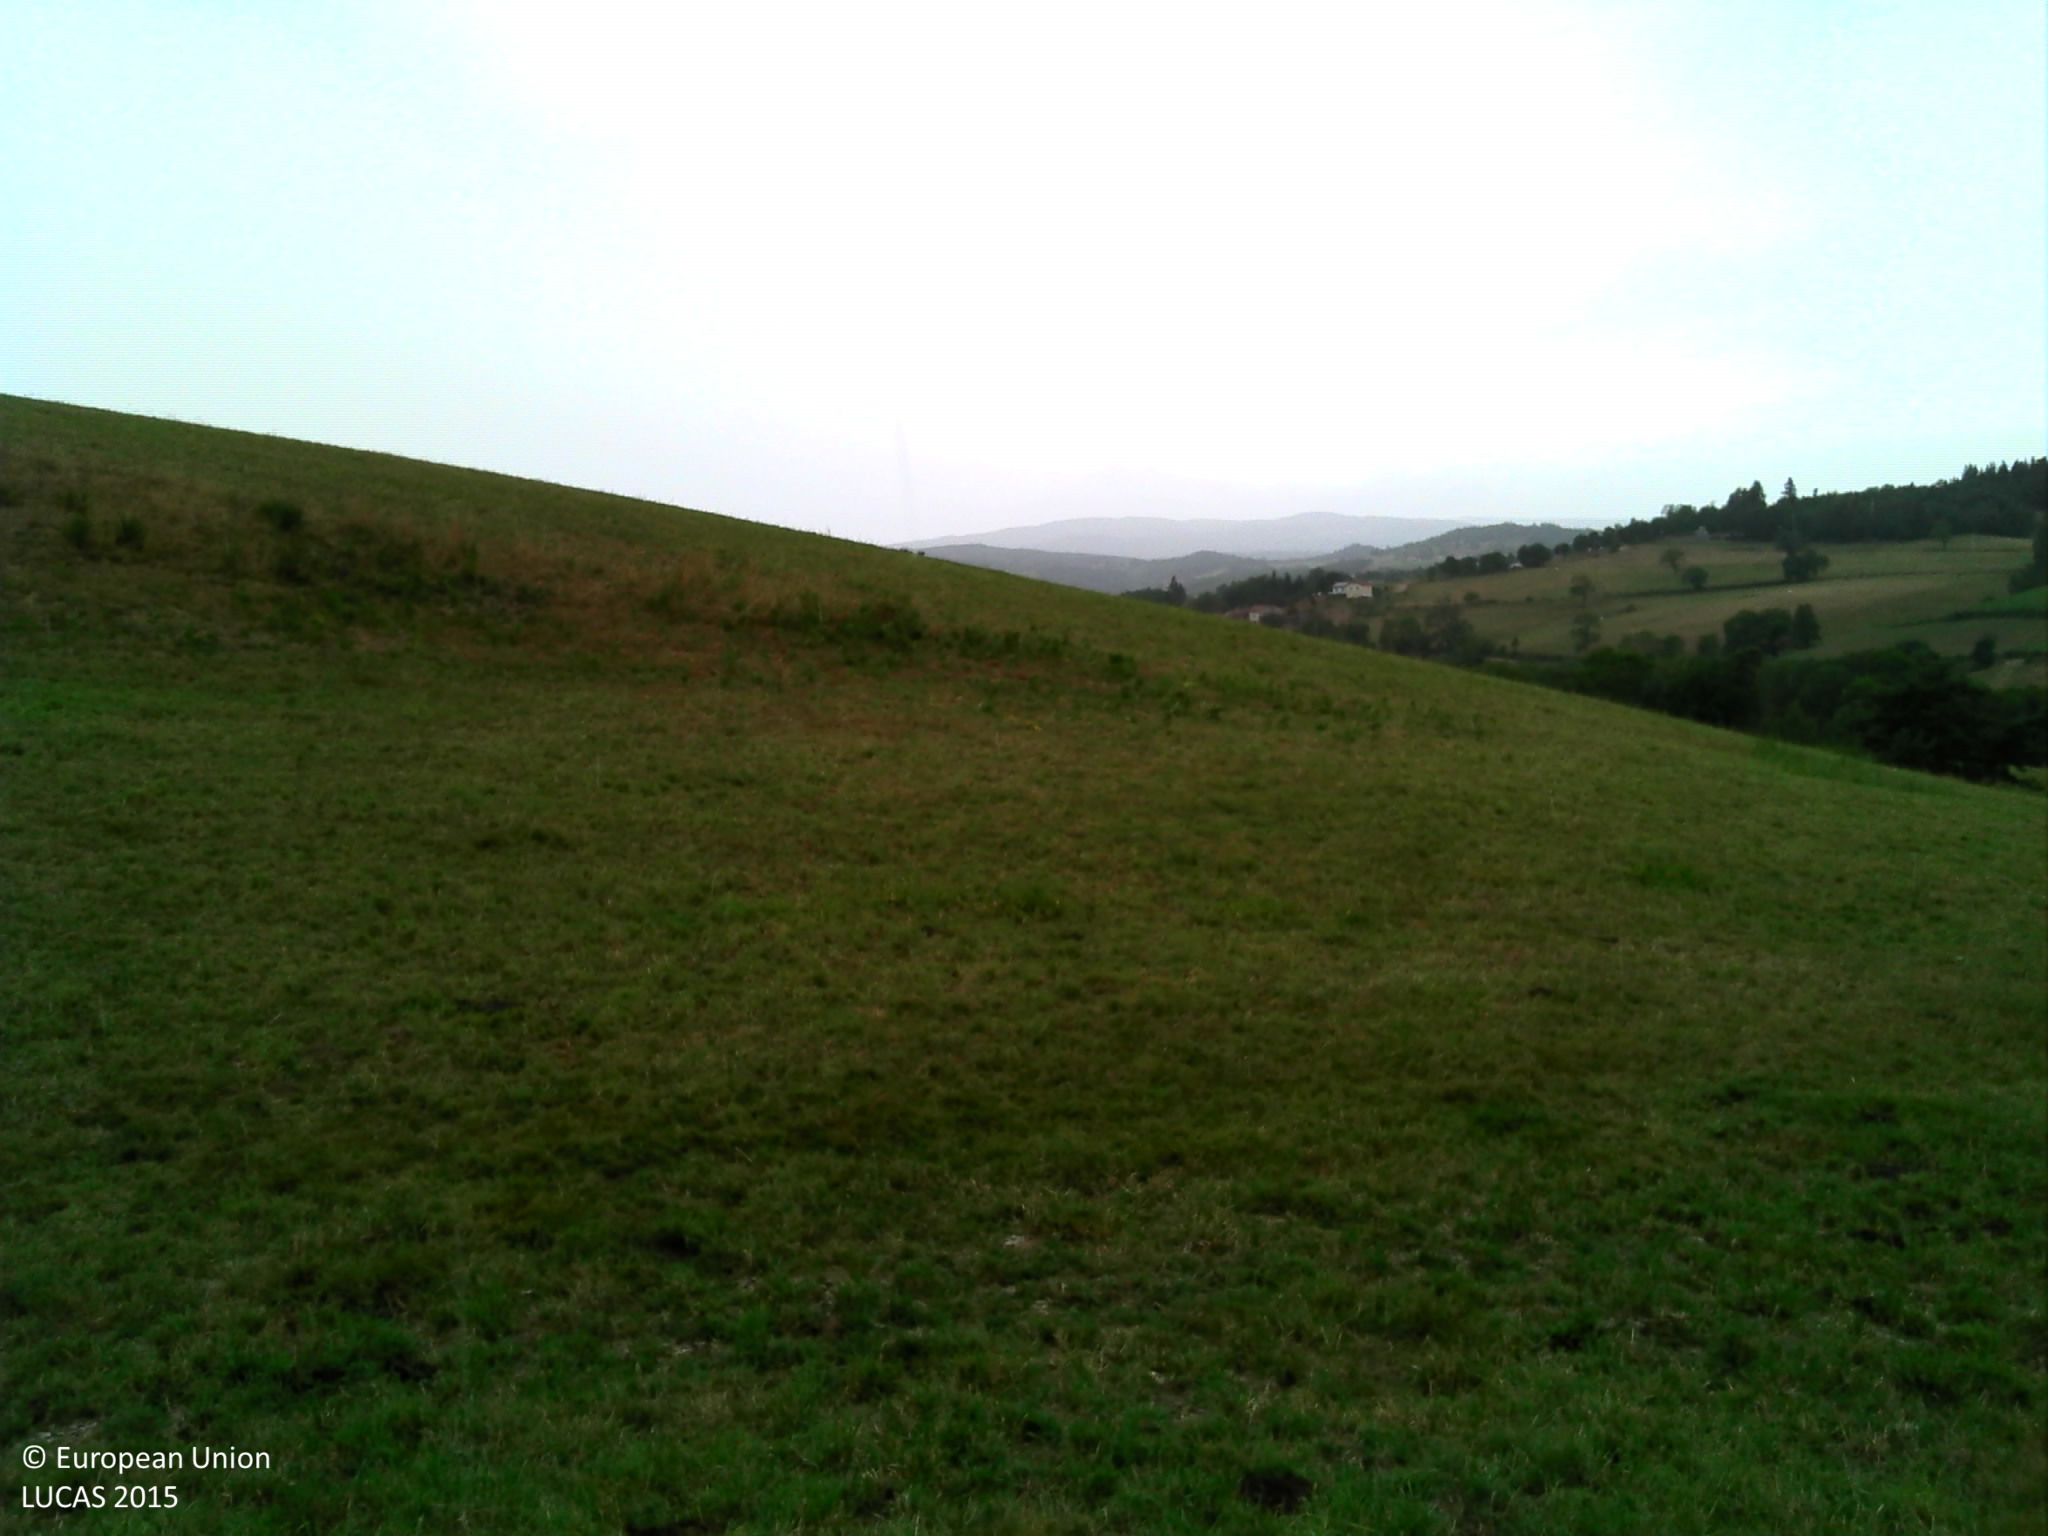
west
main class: Grassland
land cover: Grassland without tree/shrub cover
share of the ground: > 75 %
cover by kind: herbaceous plants 90 %, lichens and mosses 5 %, unconsolidated bare surface 5 %
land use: Agriculture (excluding fallow land and kitchen gardens)
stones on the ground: < 10 %
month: July
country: FR
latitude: 45.4318
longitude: 4.1364
